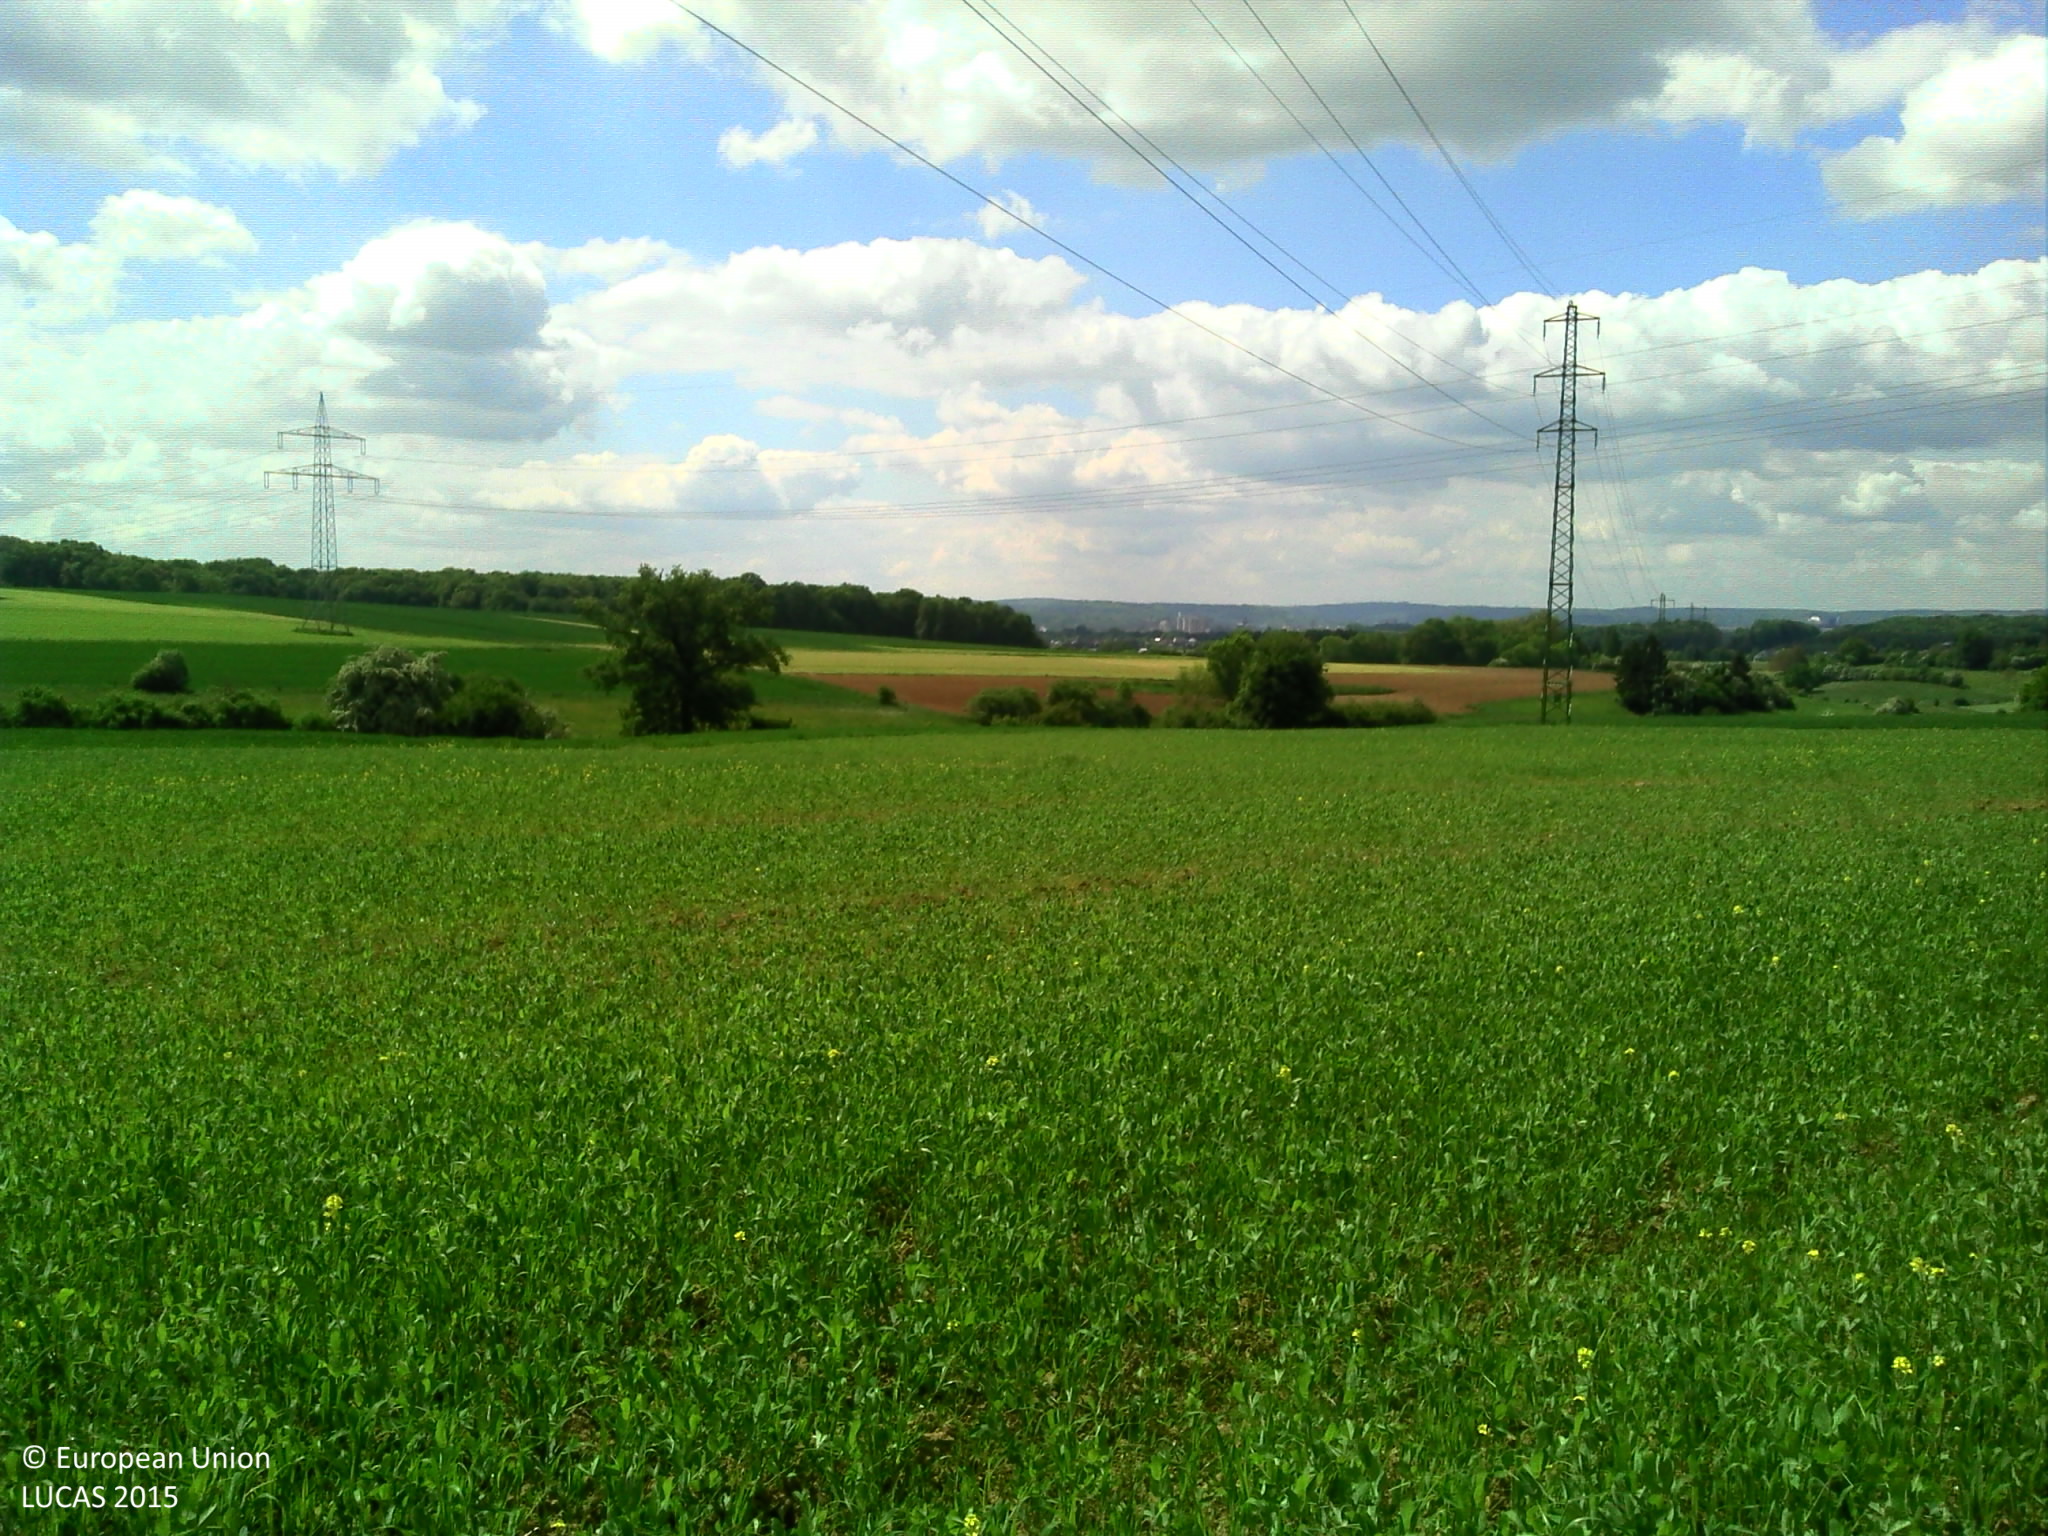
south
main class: Cropland
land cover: Other leguminous and mixtures for fodder
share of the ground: > 75 %
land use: Agriculture (excluding fallow land and kitchen gardens)
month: May
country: LU
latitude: 49.5570
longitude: 6.0318
